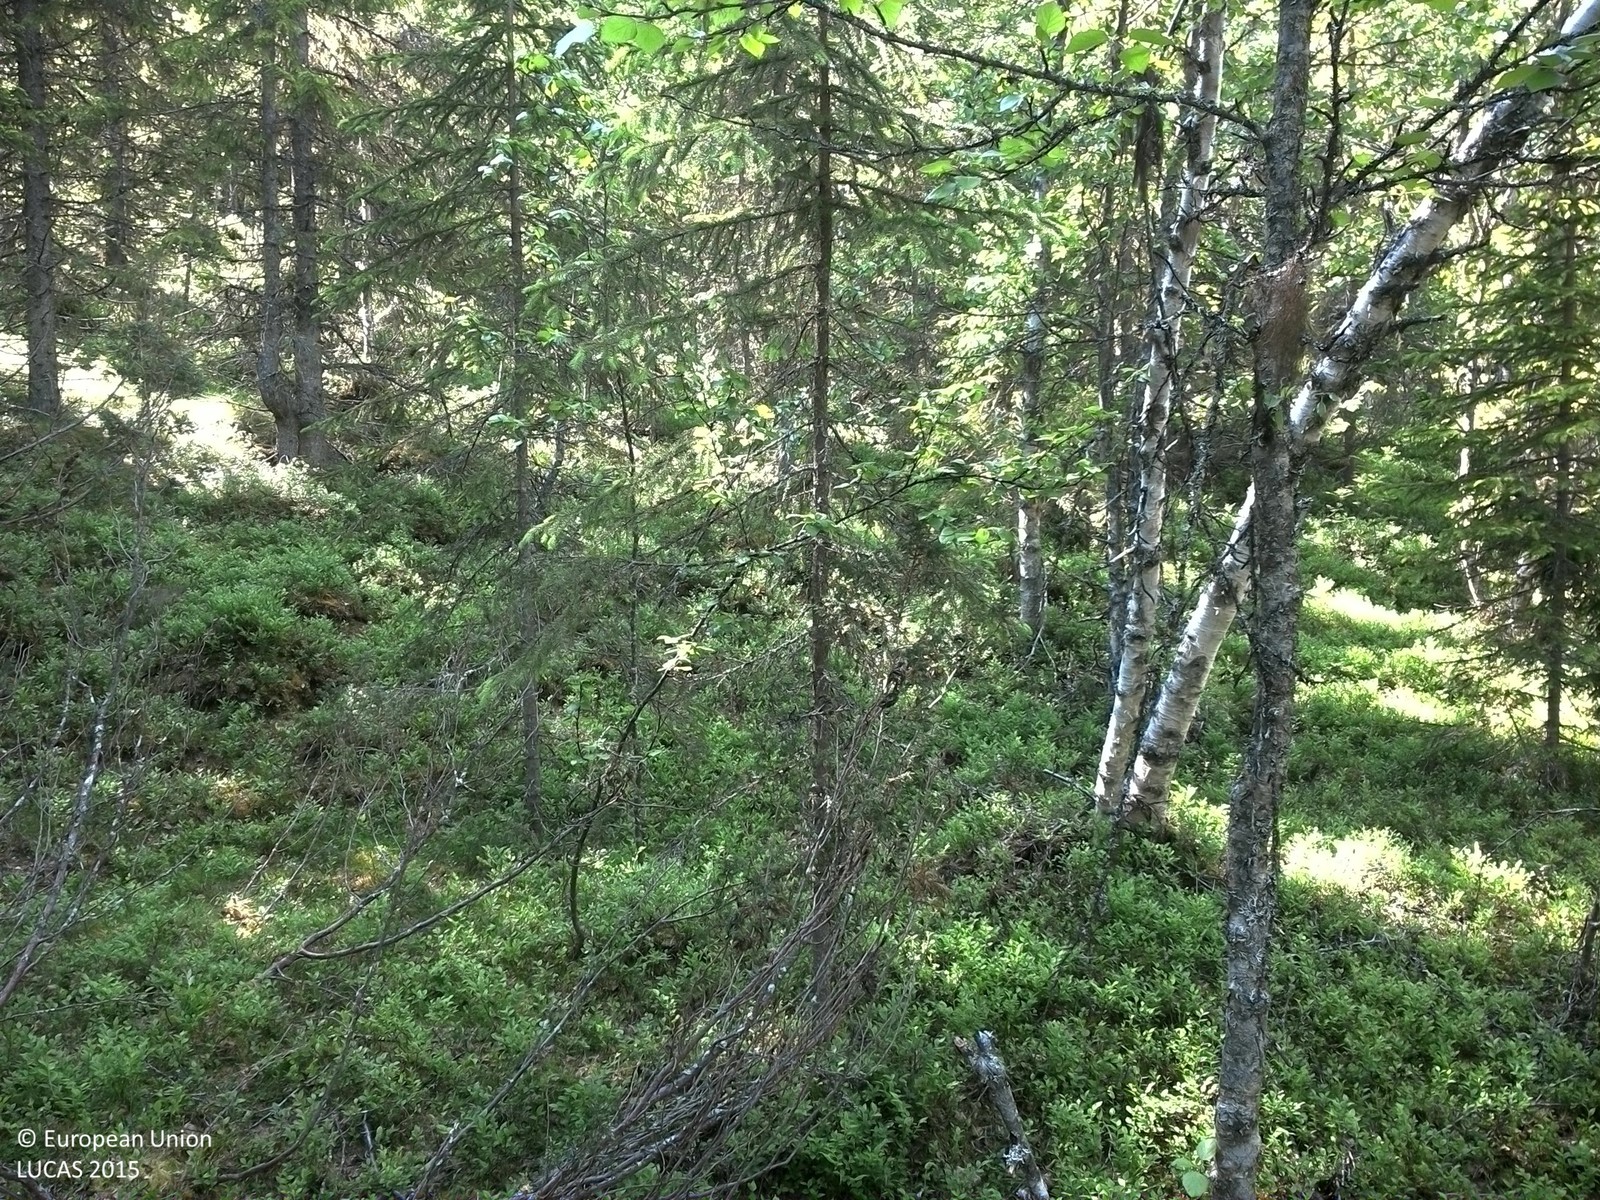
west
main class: Woodland
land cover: Spruce dominated coniferous woodland
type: boreal forest
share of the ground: 50 - 75 %
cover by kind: coniferous forest trees 50 %, shrubs 35 %, herbaceous plants 10 %, broadleaved forest trees 5 %
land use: Forestry
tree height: > 5 m
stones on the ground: 25 - 50 %
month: July
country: SE
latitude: 64.4245
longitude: 16.1350
